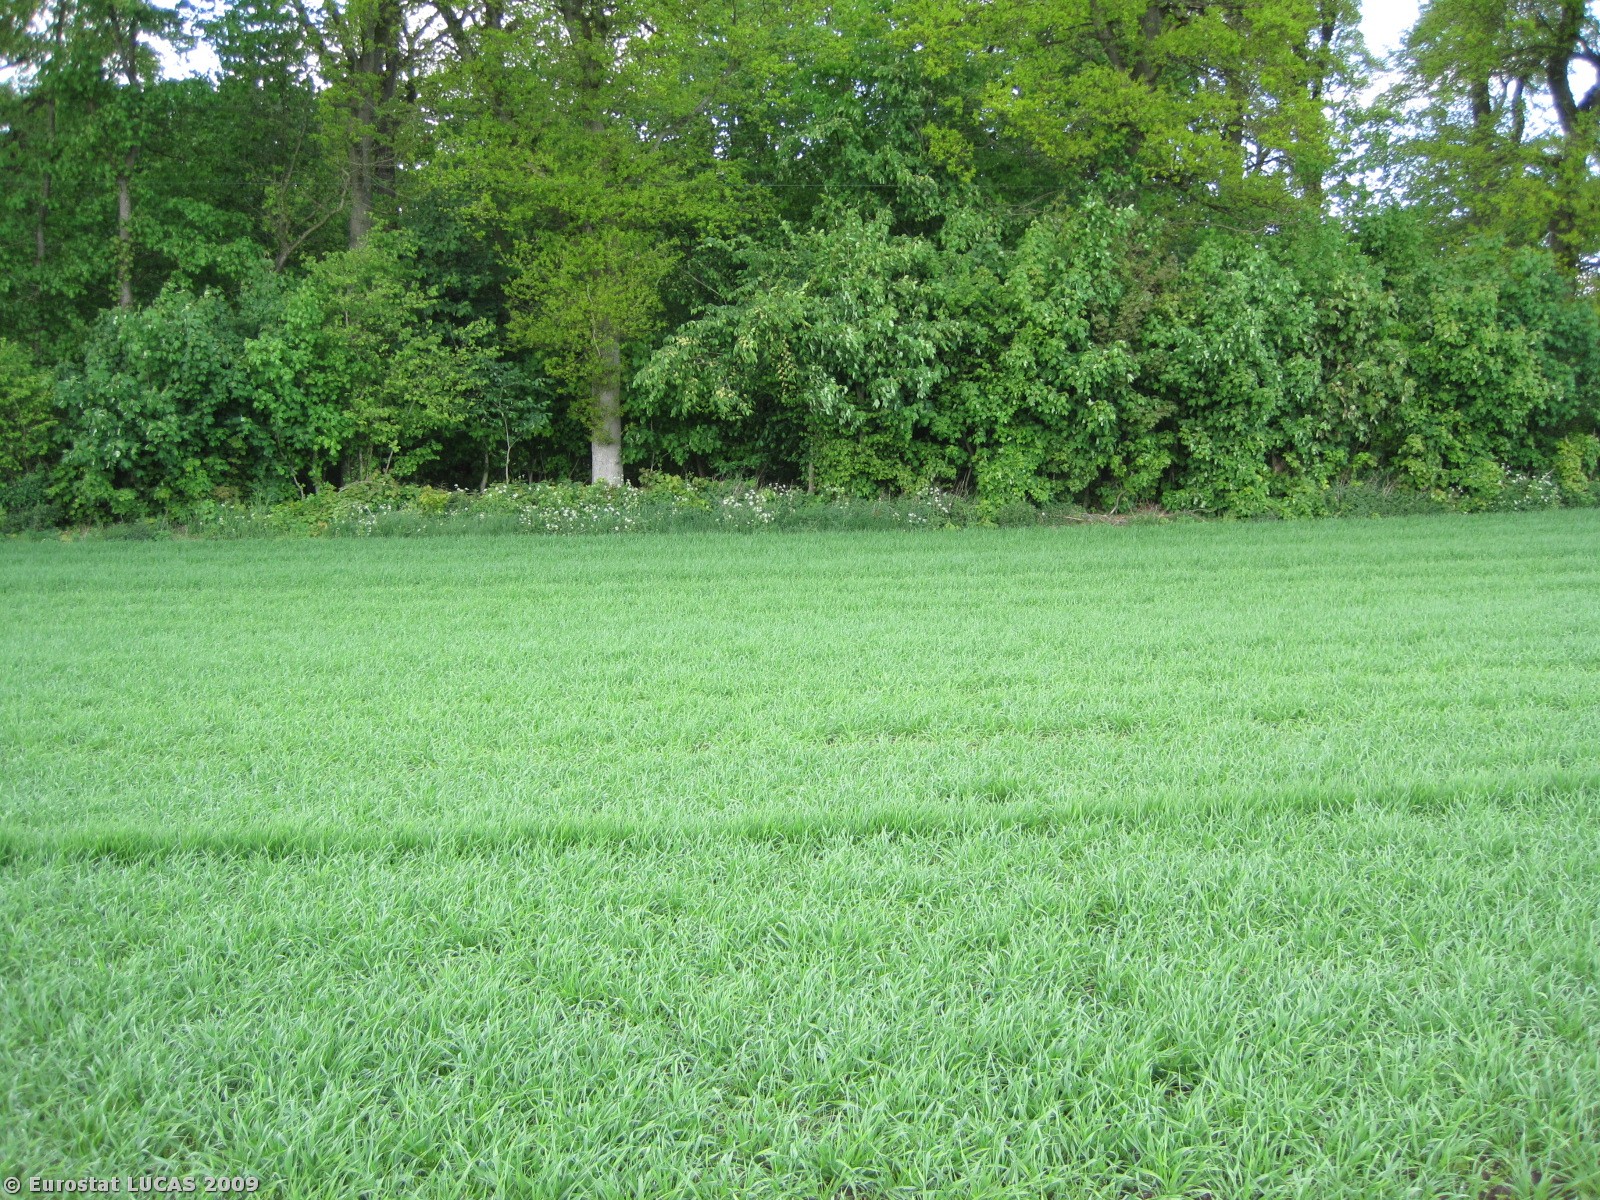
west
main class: Cropland
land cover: Barley
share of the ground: > 75 %
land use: Agriculture (excluding fallow land and kitchen gardens)
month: May
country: DK
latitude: 56.3493
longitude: 9.7576
